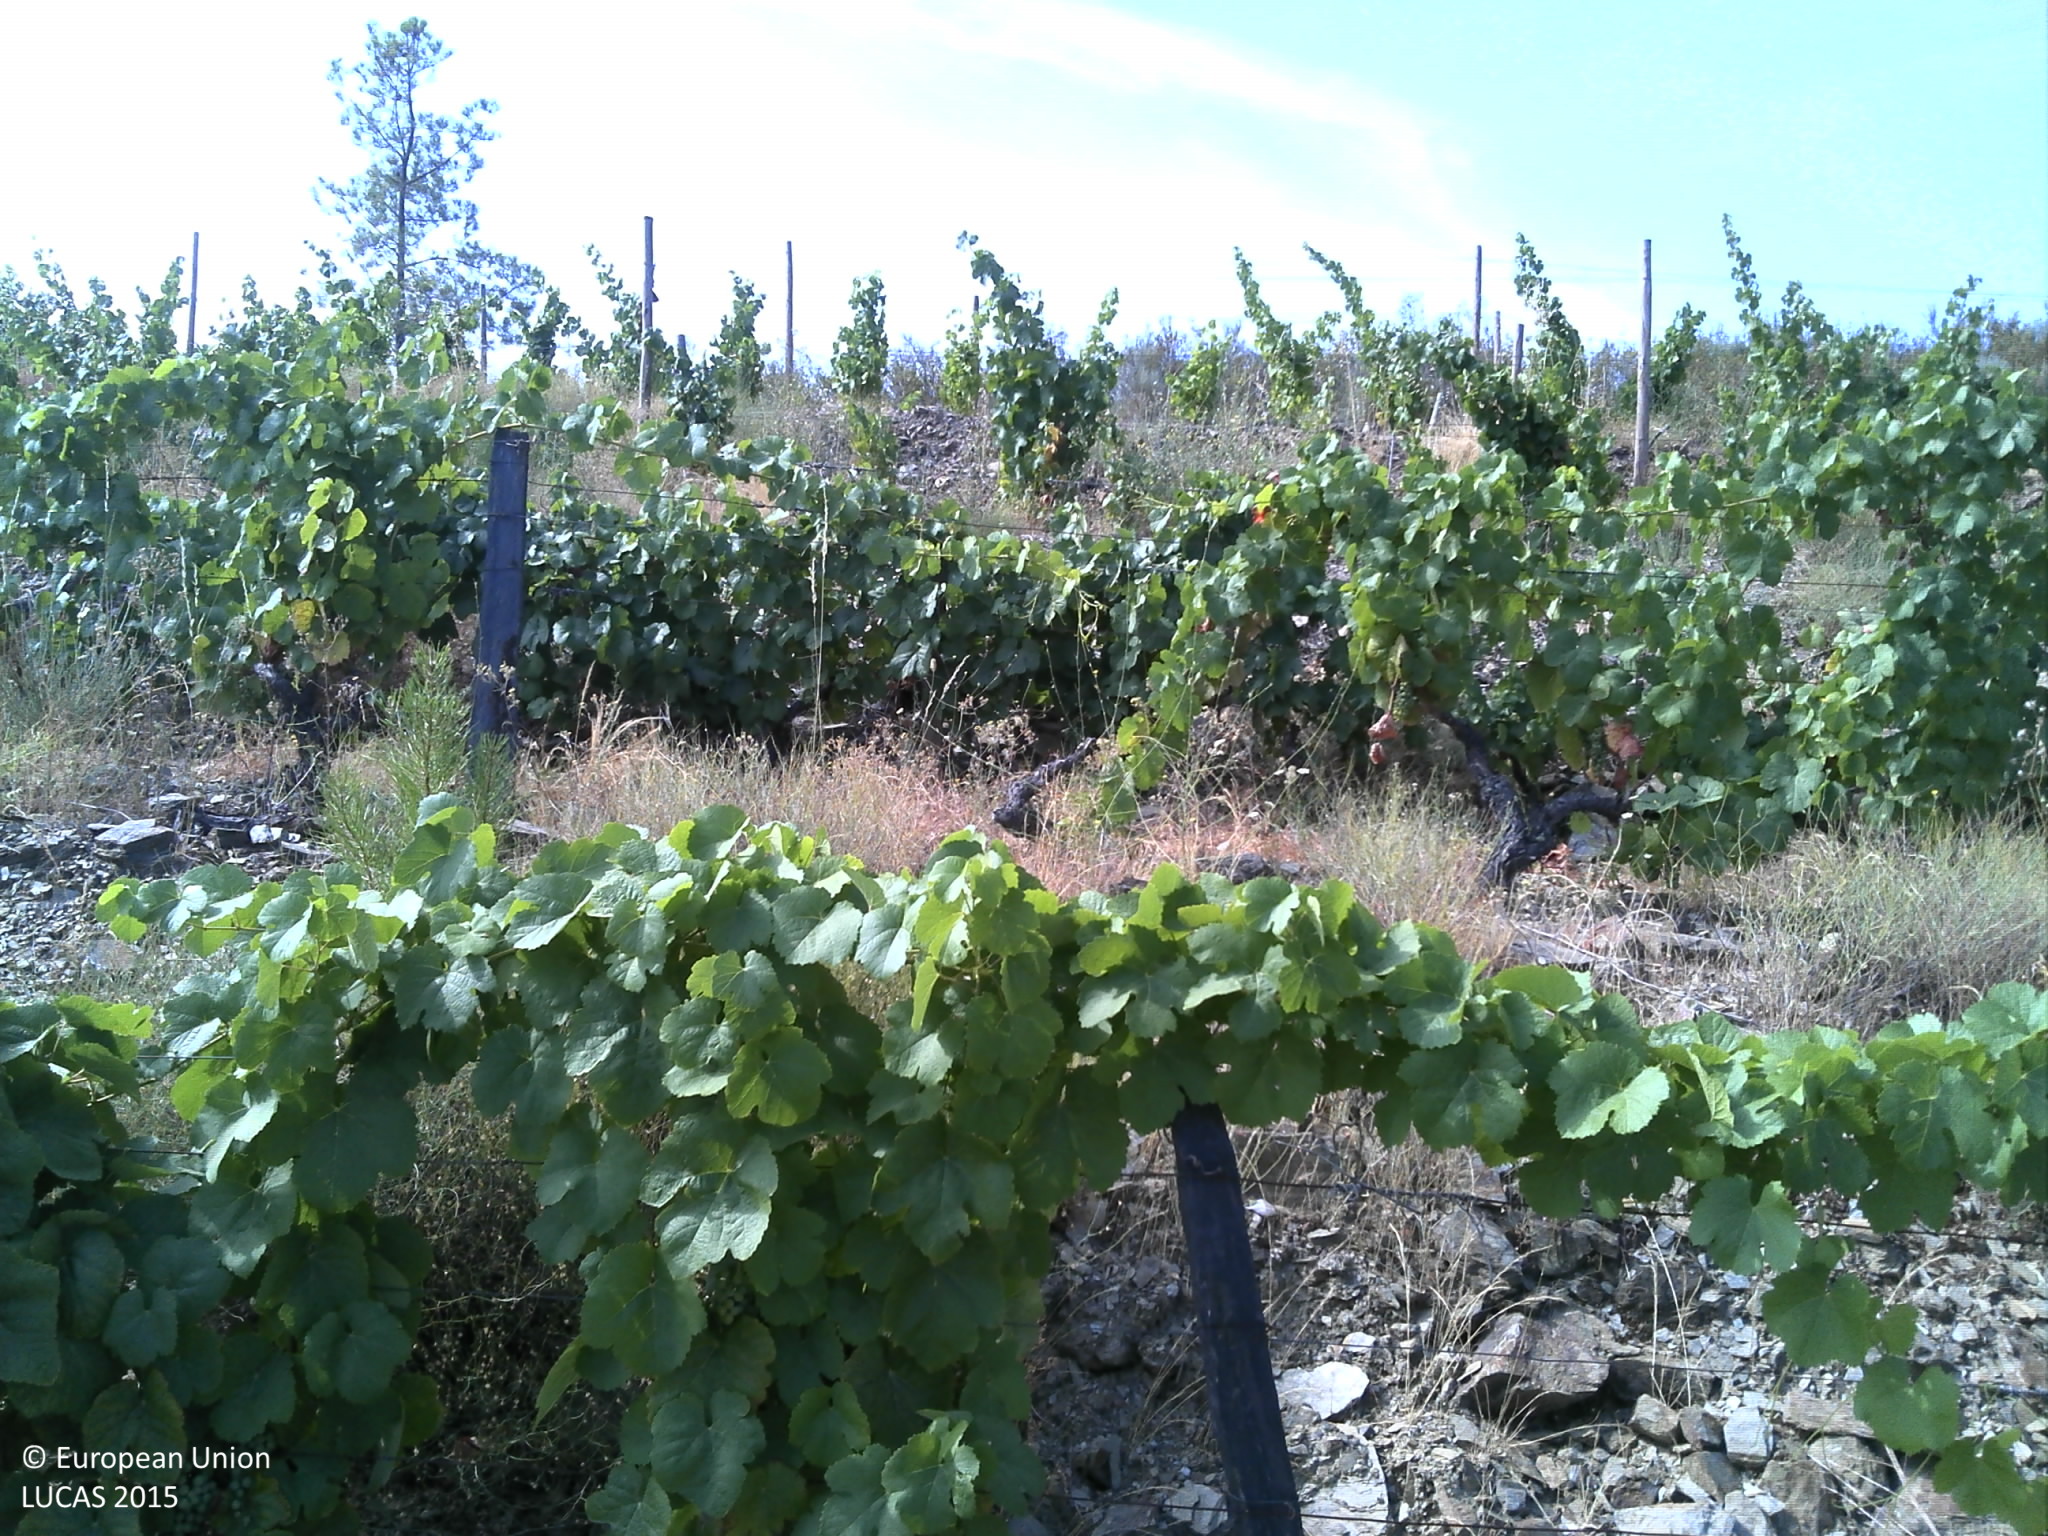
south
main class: Cropland
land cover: Vineyards
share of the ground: < 10 %
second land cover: Other bare soil
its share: > 75 %
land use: Agriculture (excluding fallow land and kitchen gardens)
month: July
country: PT
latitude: 41.0406
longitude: -7.3044
